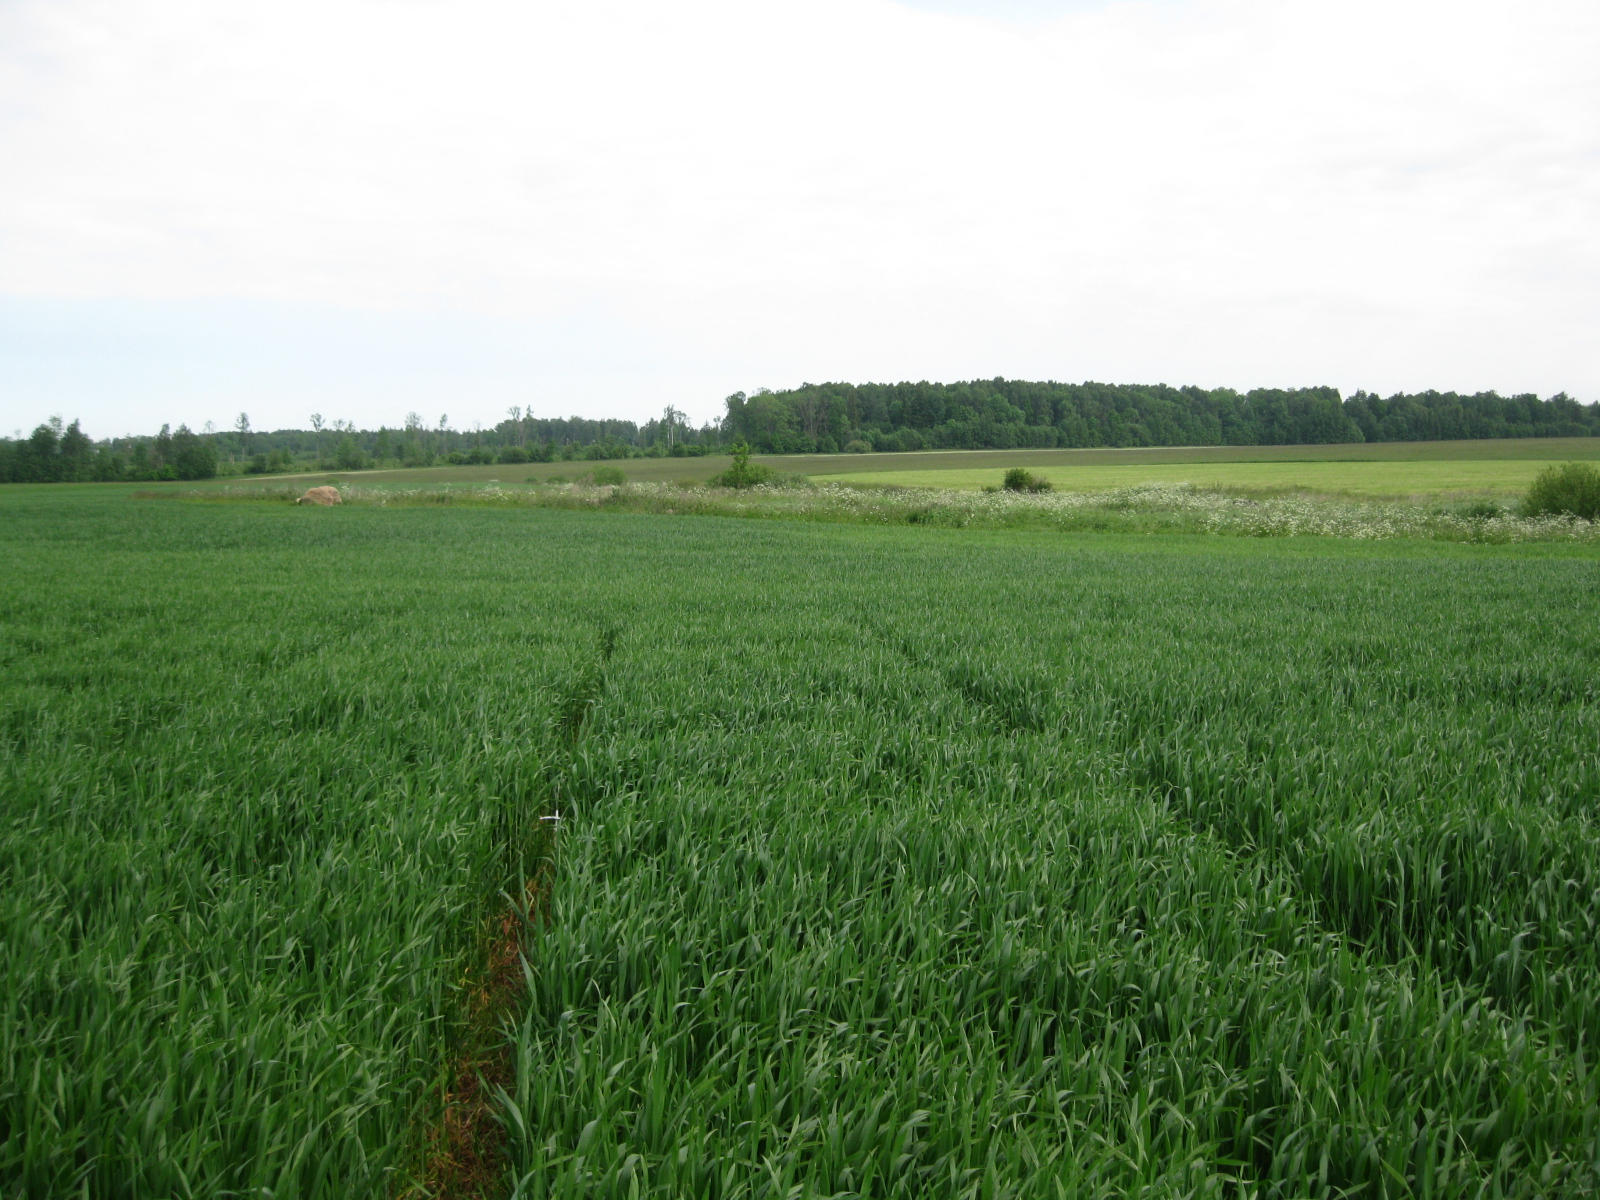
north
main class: Cropland
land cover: Barley
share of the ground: > 75 %
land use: Agriculture (excluding fallow land and kitchen gardens)
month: June
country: LT
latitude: 55.7614
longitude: 23.6754
